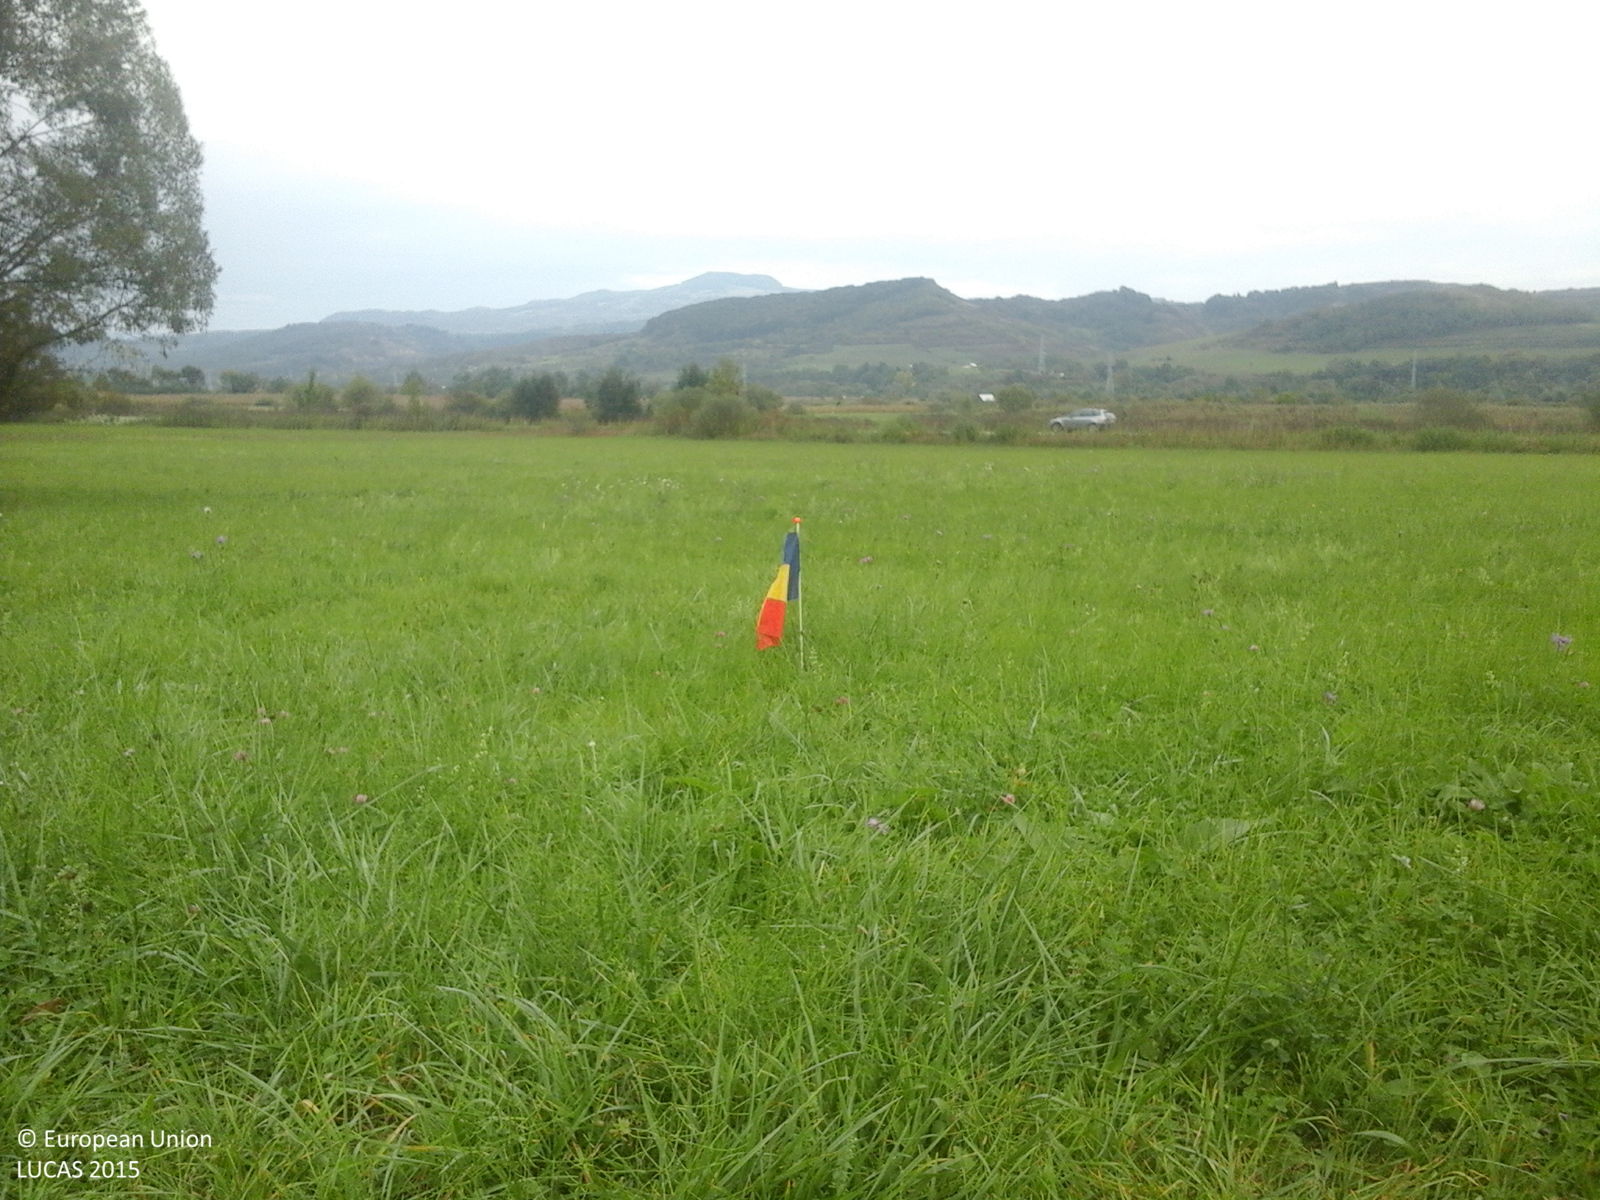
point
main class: Grassland
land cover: Grassland without tree/shrub cover
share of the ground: > 75 %
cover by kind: herbaceous plants 100 %
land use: Agriculture (excluding fallow land and kitchen gardens)
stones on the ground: < 10 %
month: October
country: RO
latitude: 46.5205
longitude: 24.9433
